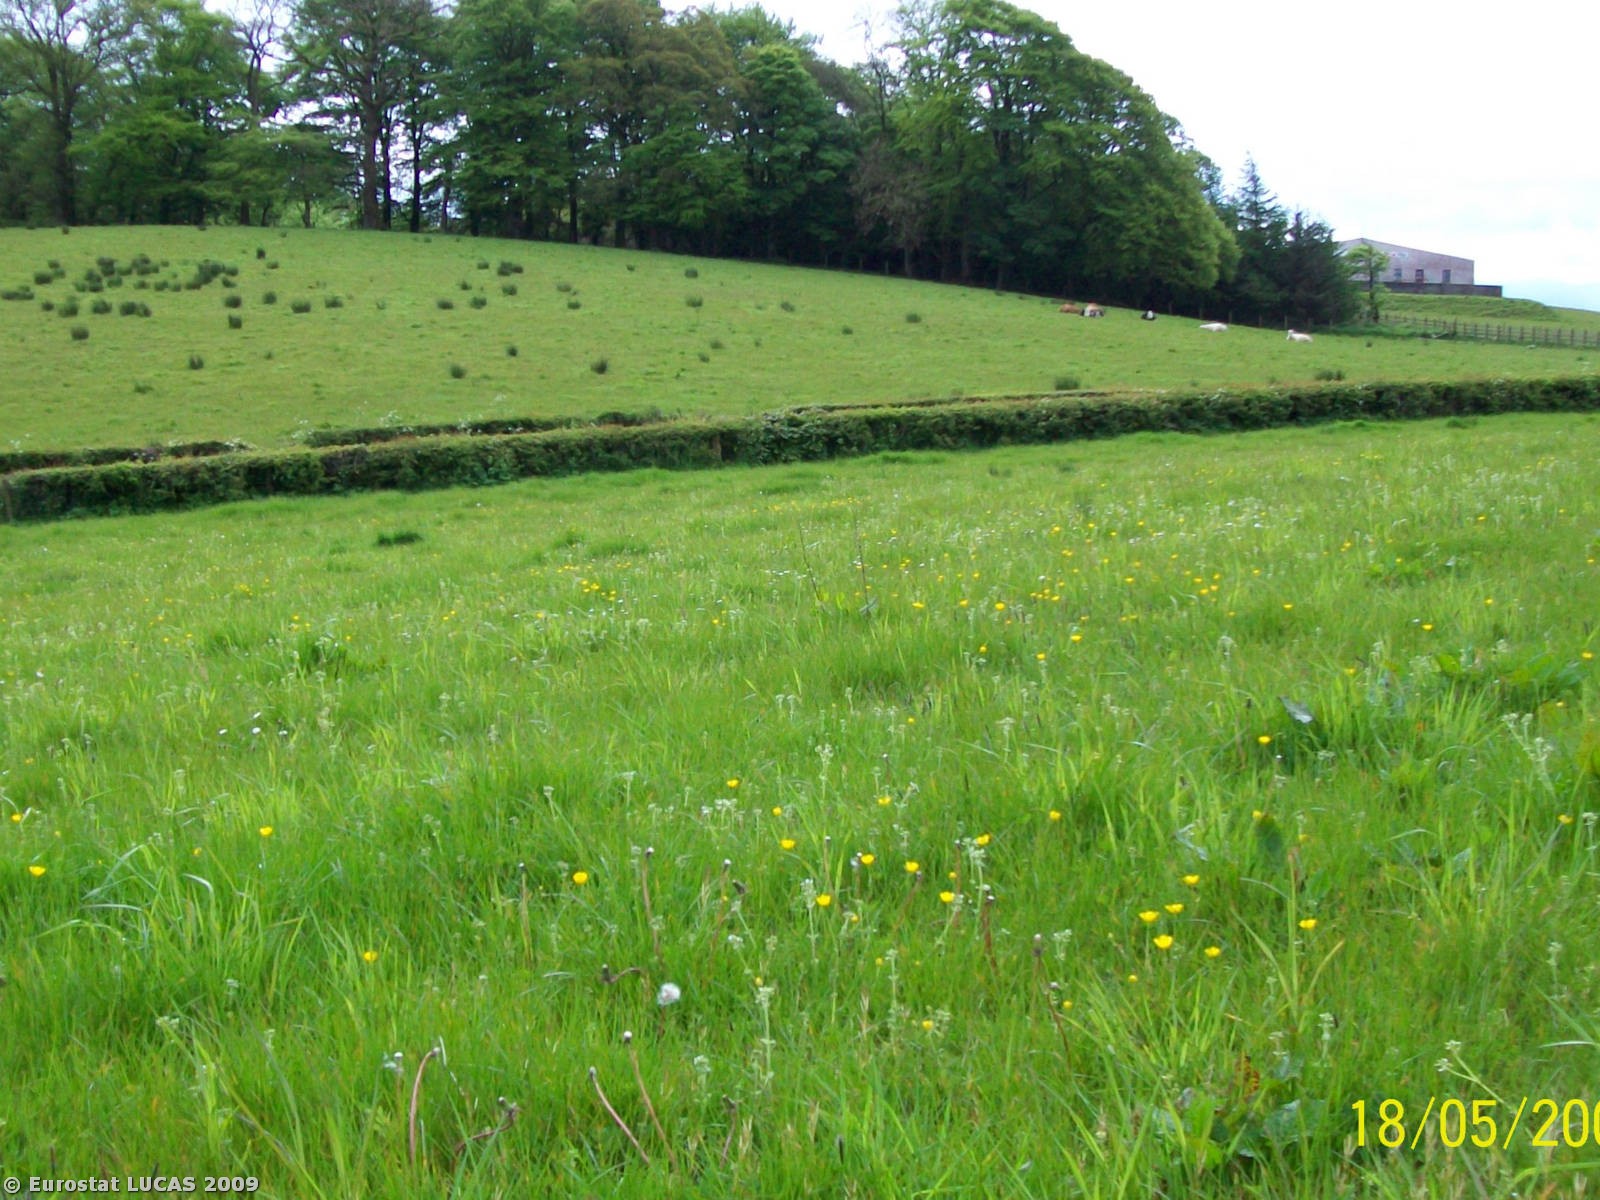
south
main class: Grassland
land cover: Grassland without tree/shrub cover
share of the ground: > 75 %
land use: Agriculture (excluding fallow land and kitchen gardens)
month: May
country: GB
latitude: 54.5523
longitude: -7.3272
